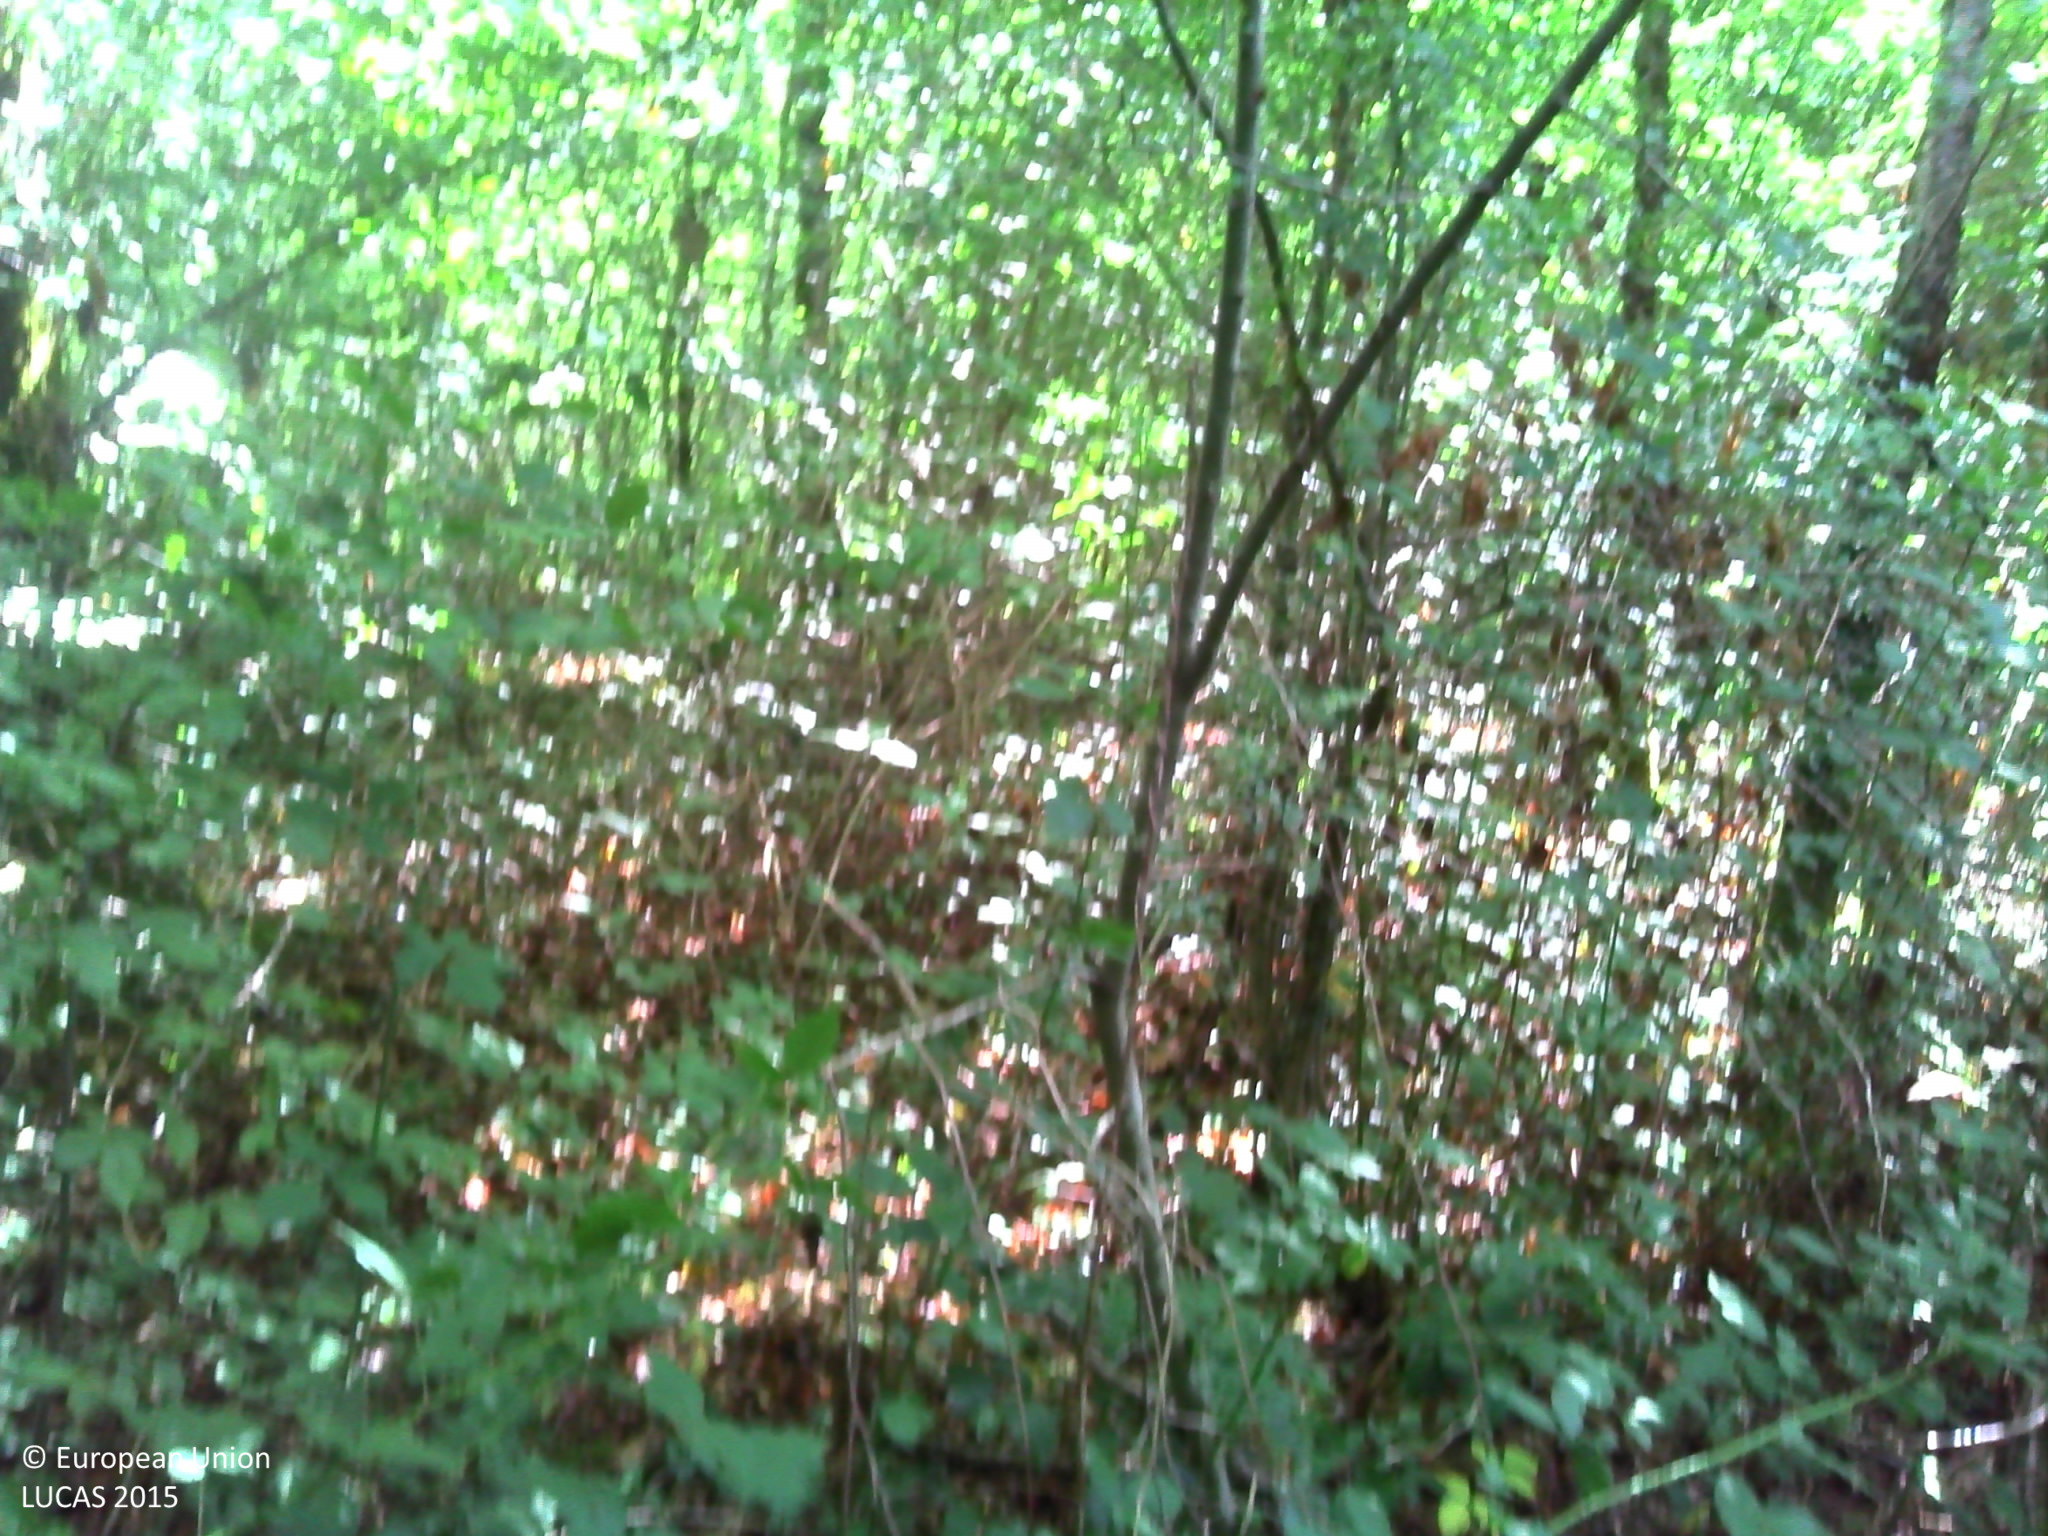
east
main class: Woodland
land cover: Broadleaved woodland
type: mesophytic deciduous forest
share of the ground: > 75 %
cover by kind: broadleaved forest trees 100 %
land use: Forestry
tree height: > 5 m
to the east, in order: Broadleaved woodland
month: August
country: FR
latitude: 47.1276
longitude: 2.1212
